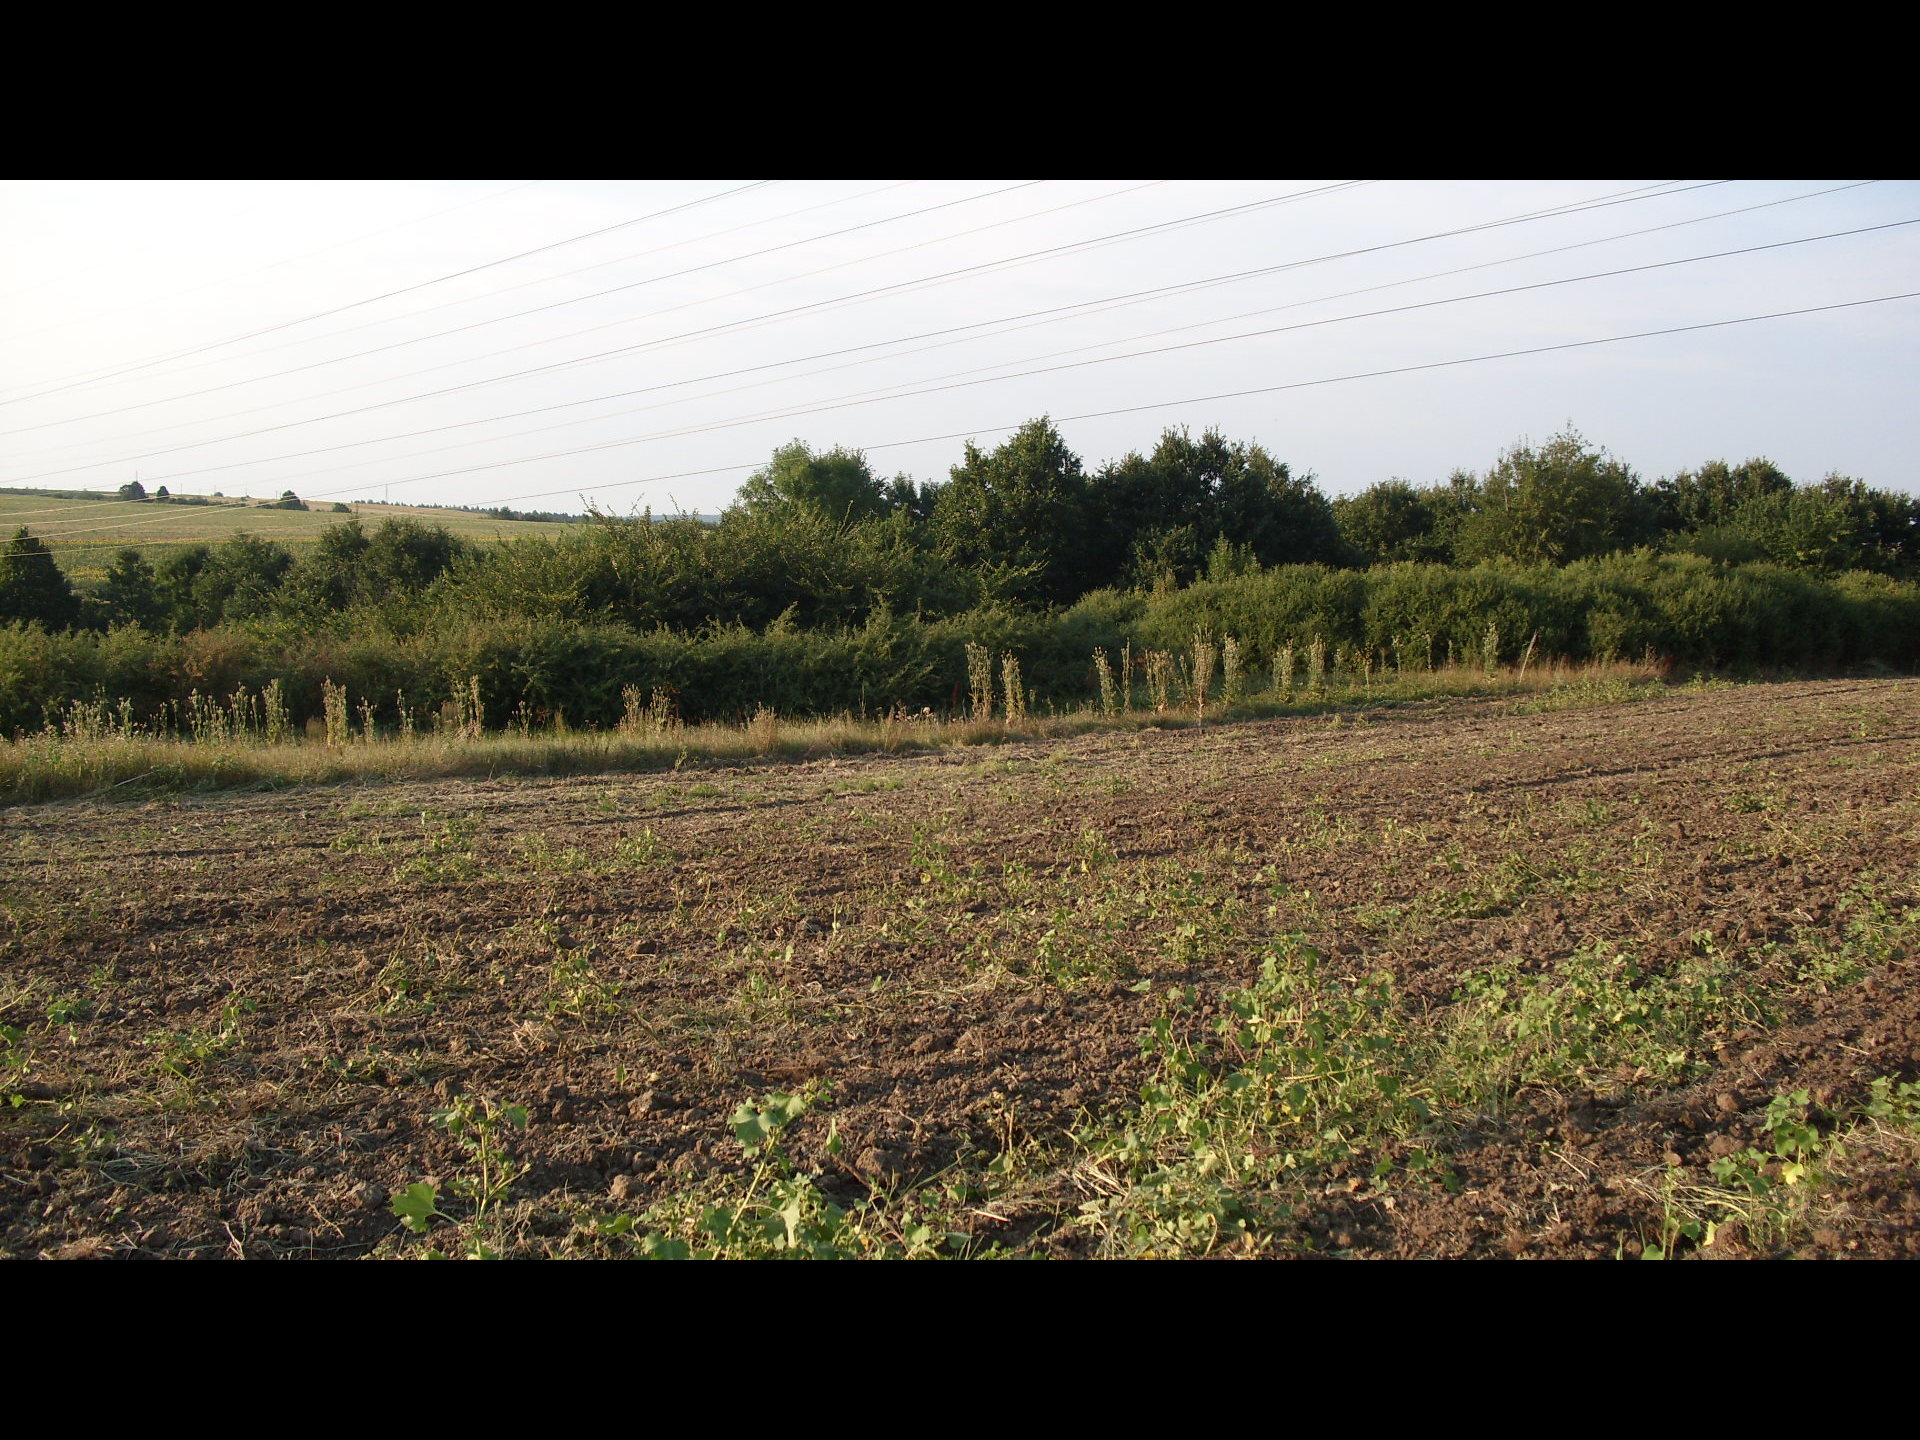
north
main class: Grassland
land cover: Spontaneously vegetated surfaces
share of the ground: 10 - 25 %
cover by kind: herbaceous plants 100 %
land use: Fallow land
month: August
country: BG
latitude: 43.3391
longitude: 23.4753
